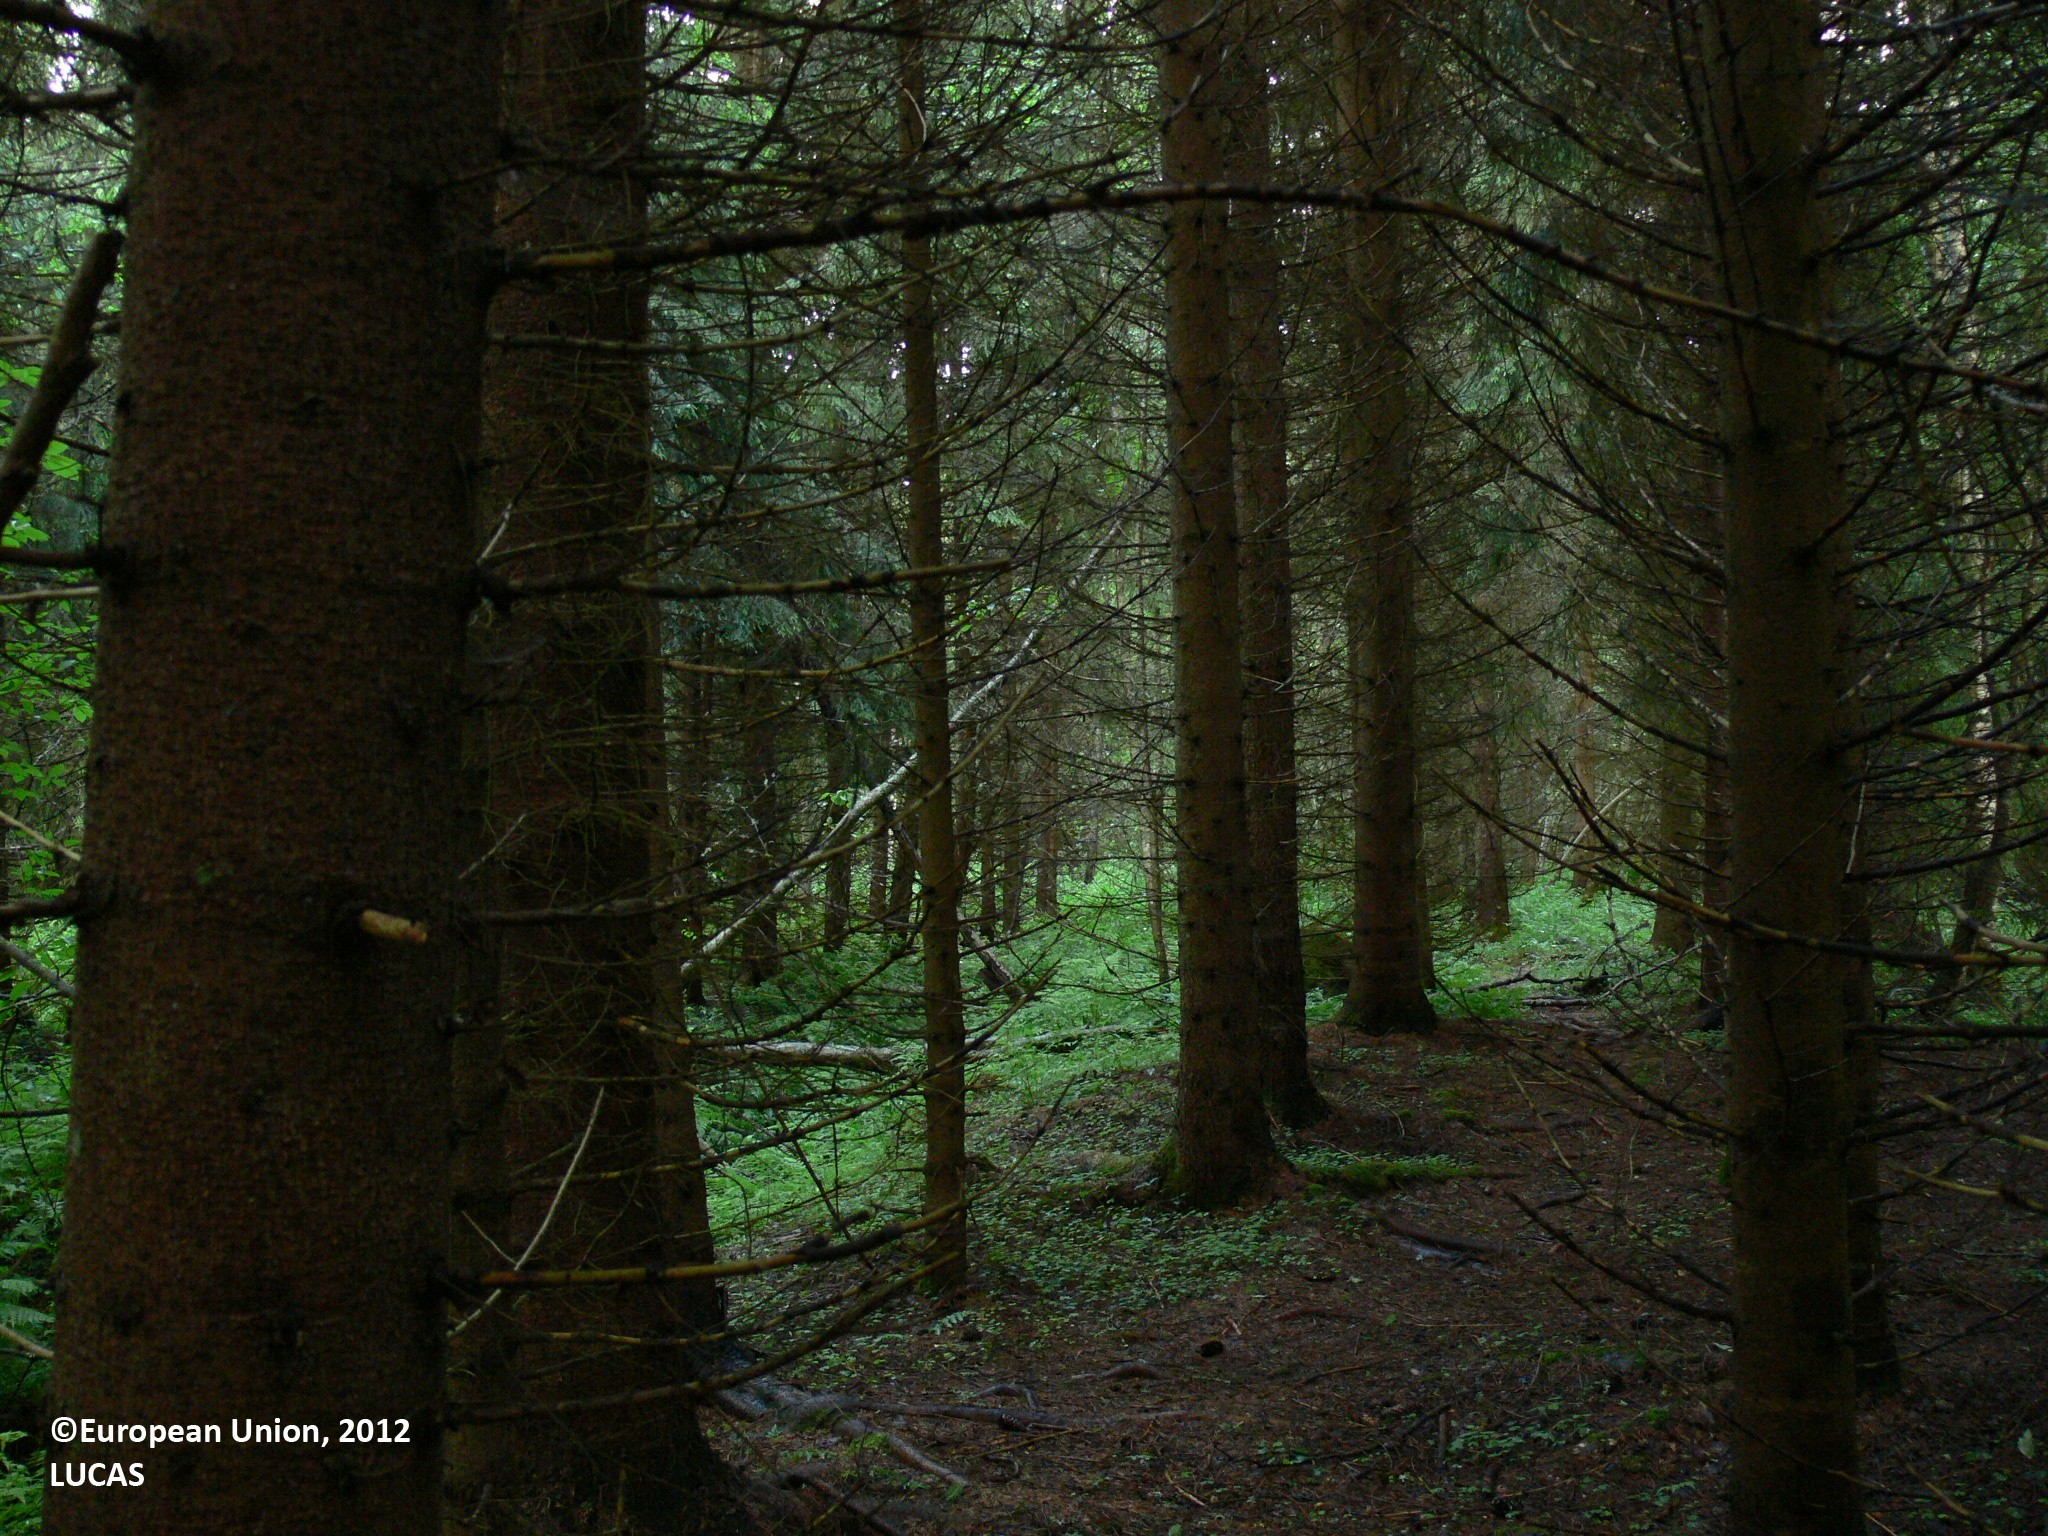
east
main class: Woodland
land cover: Spruce dominated mixed woodland
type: boreal forest
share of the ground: > 75 %
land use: Forestry
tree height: > 5 m
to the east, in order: Spruce dominated mixed woodland; Spruce dominated coniferous woodland; Ditches and canals; Spruce dominated coniferous woodland; Spruce dominated mixed woodland; Grass margins; Paved roads, cycling and walking lanes; Grass margins; Ditches and canals; Spruce dominated mixed woodland; Ditches and canals; Spruce dominated mixed woodland
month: June
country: FI
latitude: 62.5584
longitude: 29.4339
